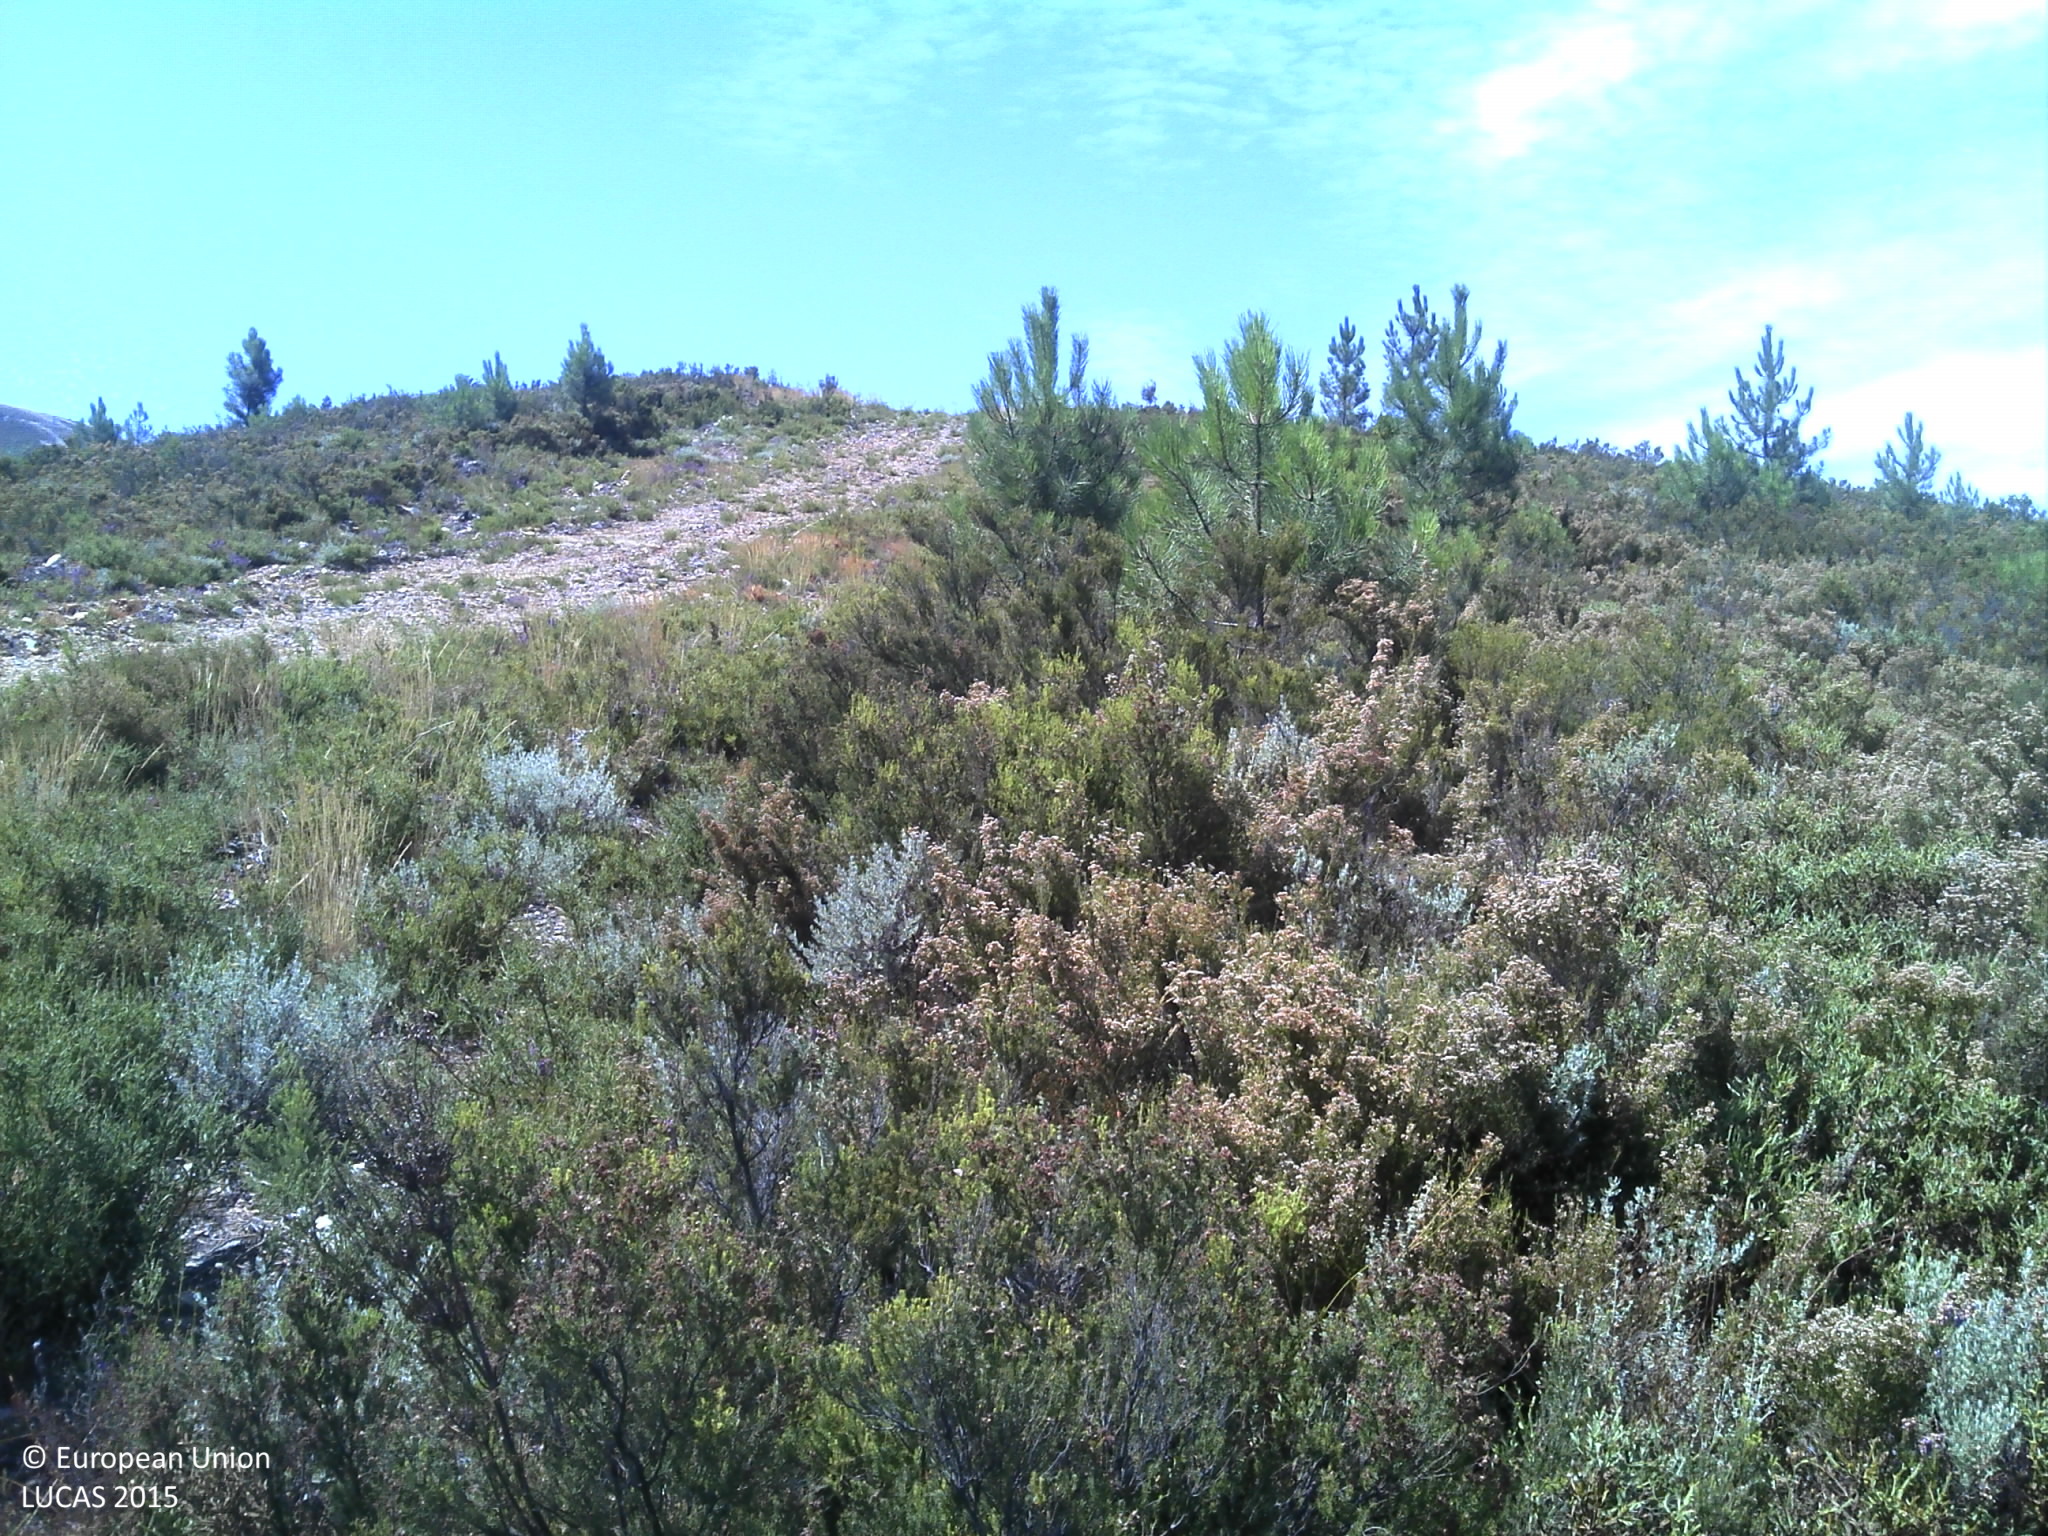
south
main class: Shrubland
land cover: Shrubland without tree cover
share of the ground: > 75 %
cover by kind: shrubs 90 %, unconsolidated bare surface 10 %
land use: Semi-natural and natural areas not in use
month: July
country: PT
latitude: 40.1575
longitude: -7.9018
